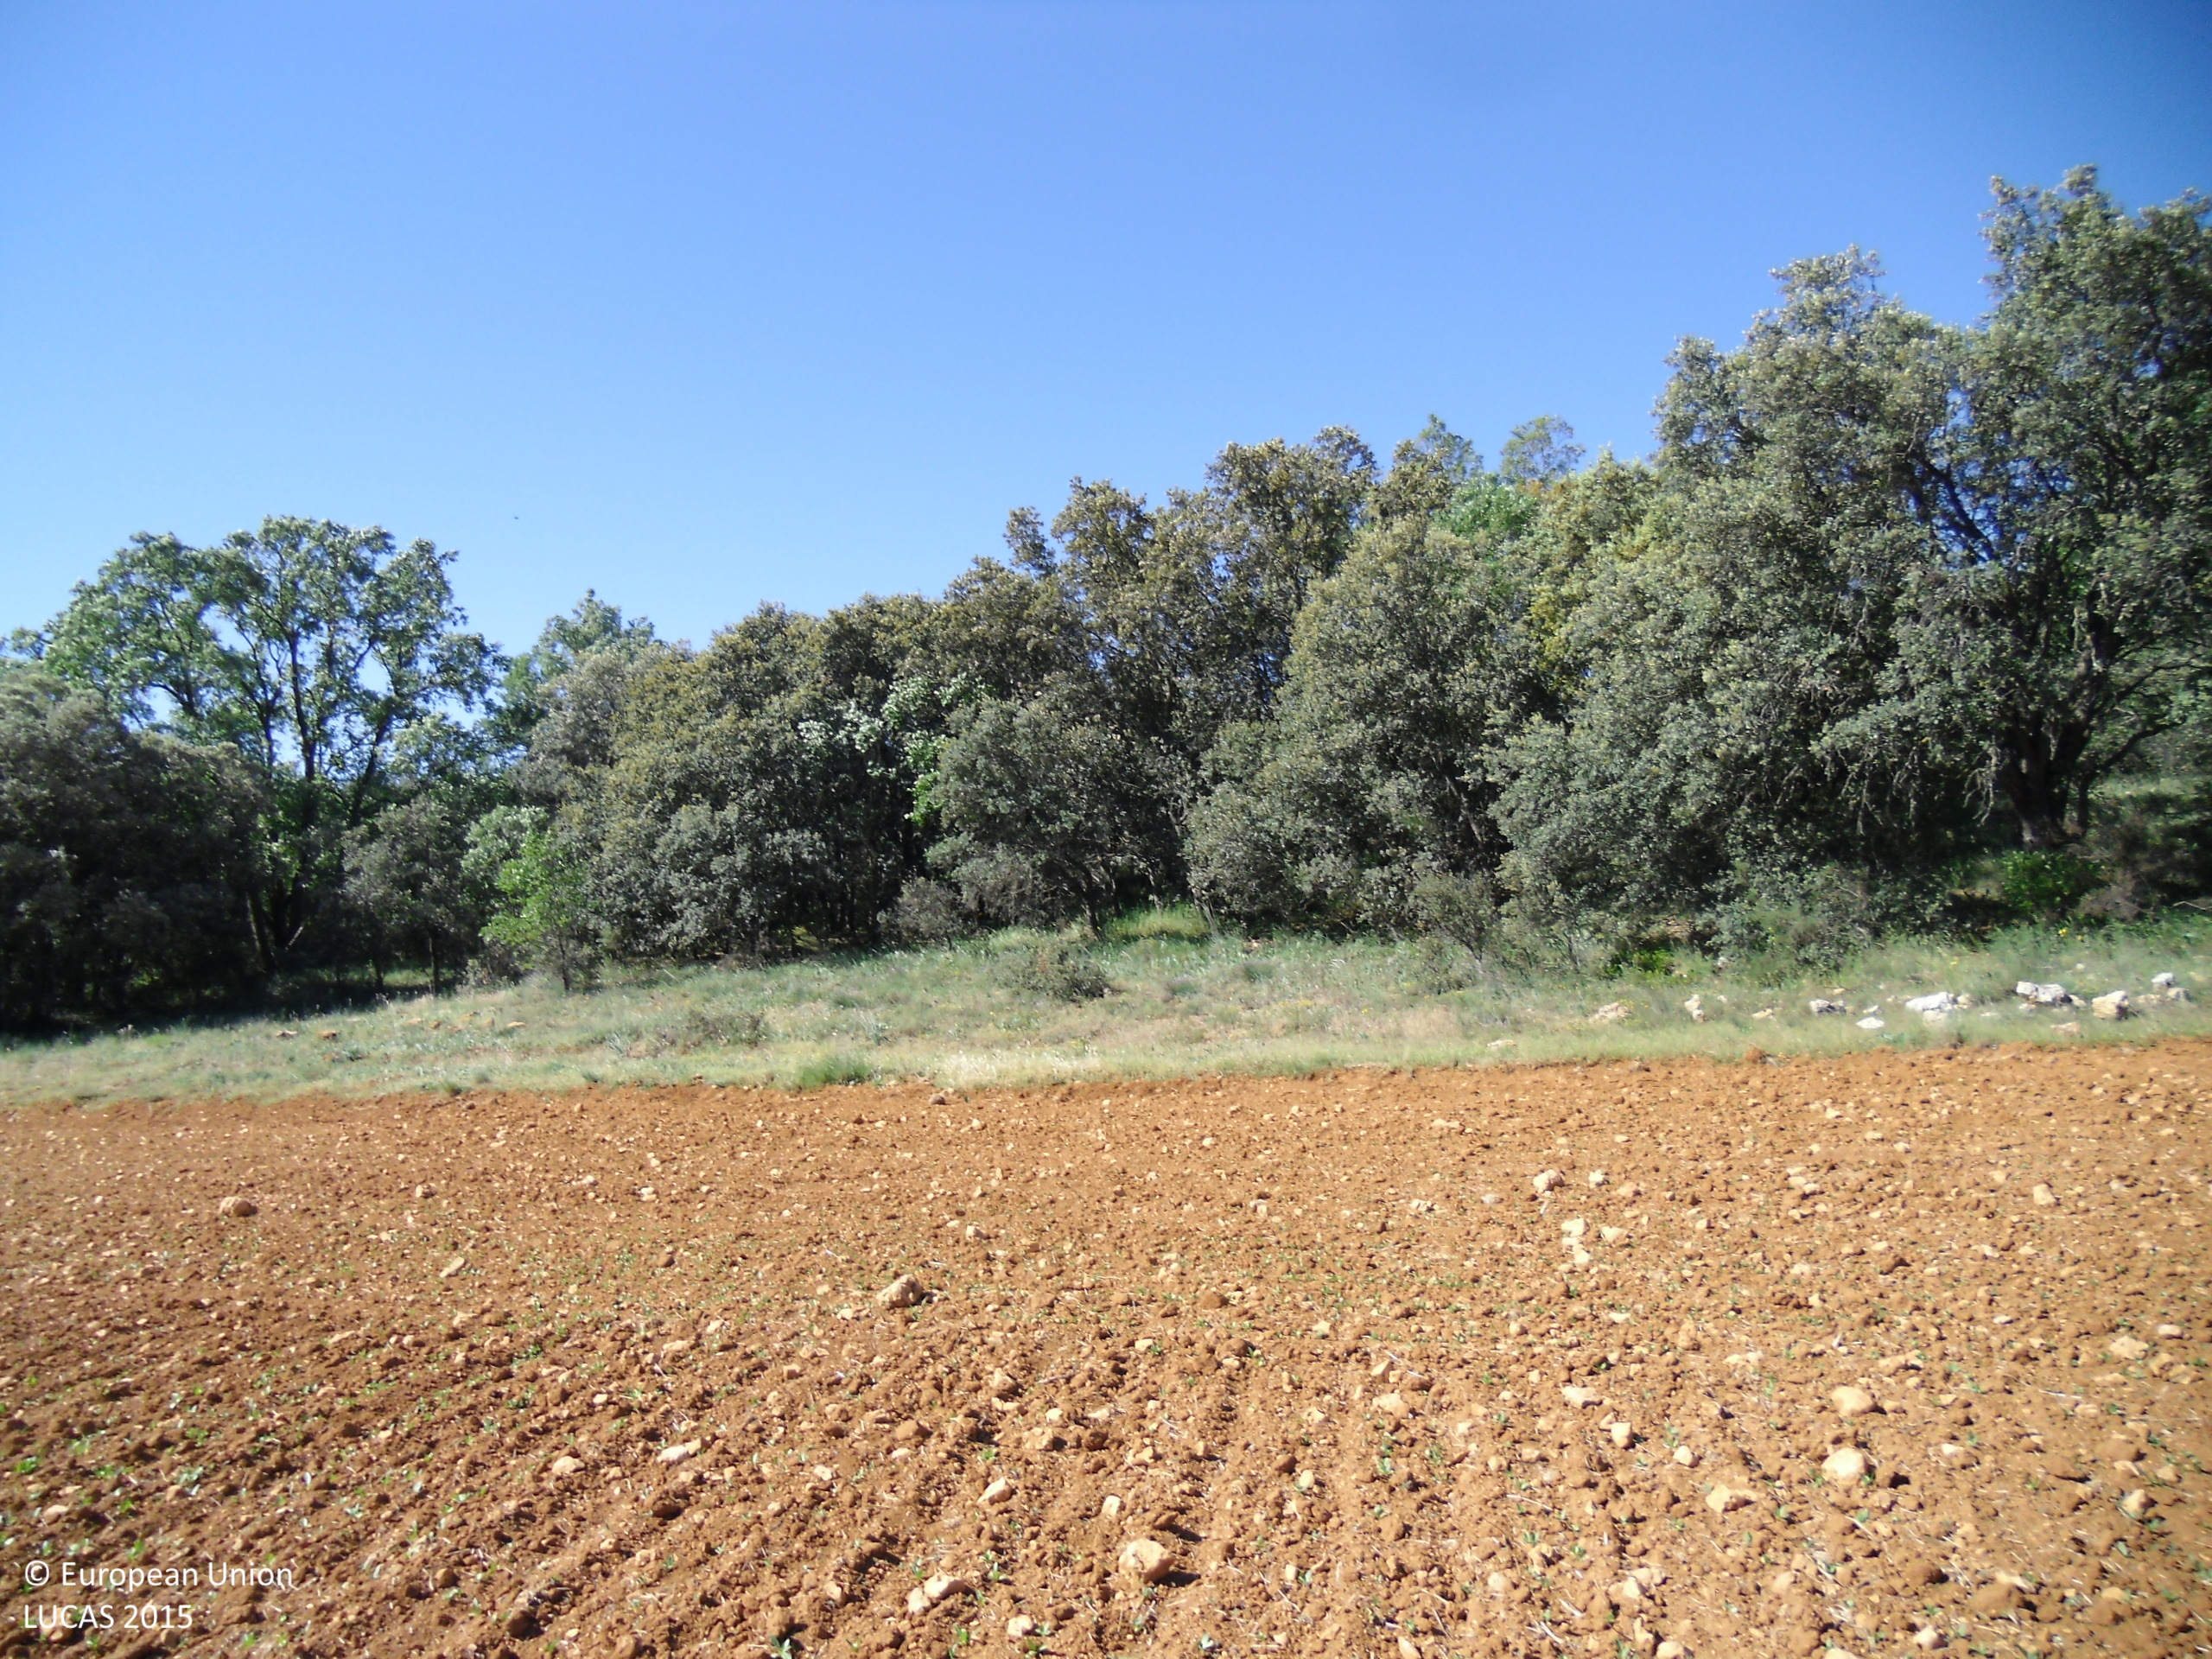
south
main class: Cropland
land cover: Soya
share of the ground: < 10 %
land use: Agriculture (excluding fallow land and kitchen gardens)
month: May
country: ES
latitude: 40.2031
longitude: -2.8654
